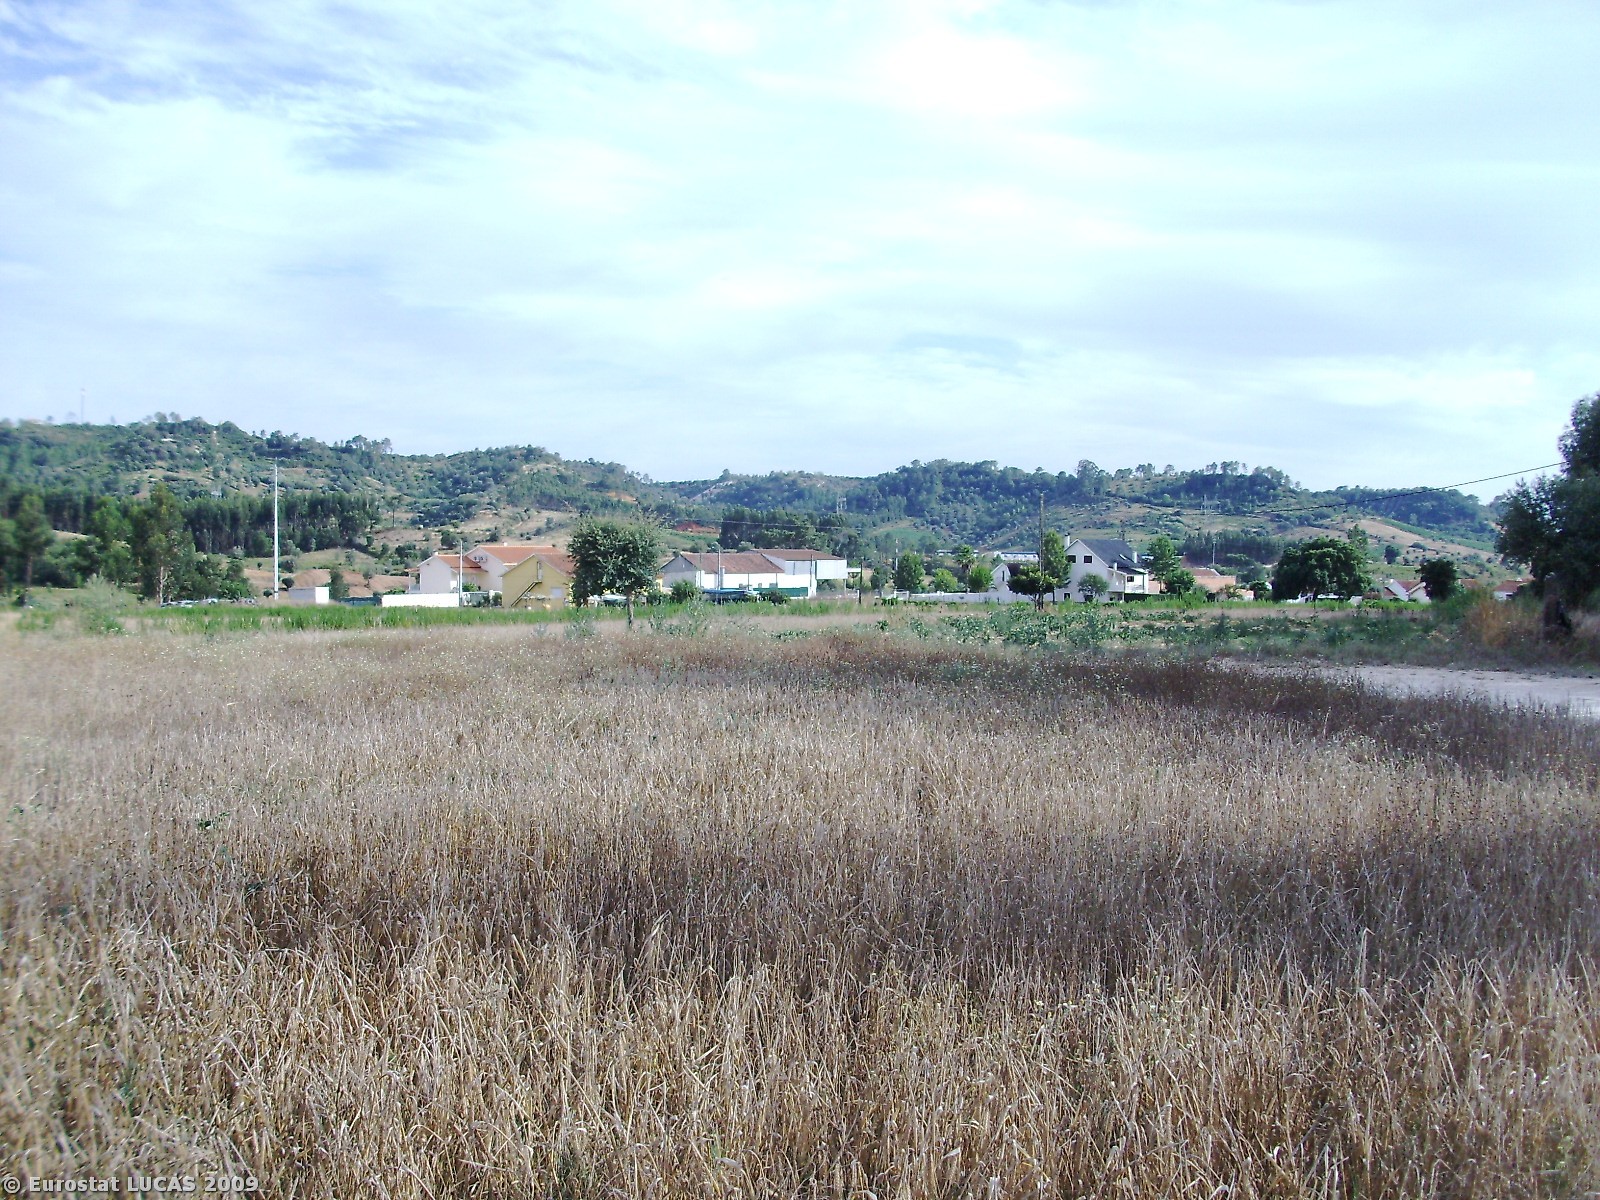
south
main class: Cropland
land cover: Barley
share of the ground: > 75 %
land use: Agriculture (excluding fallow land and kitchen gardens)
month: July
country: PT
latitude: 39.3621
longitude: -8.7749
